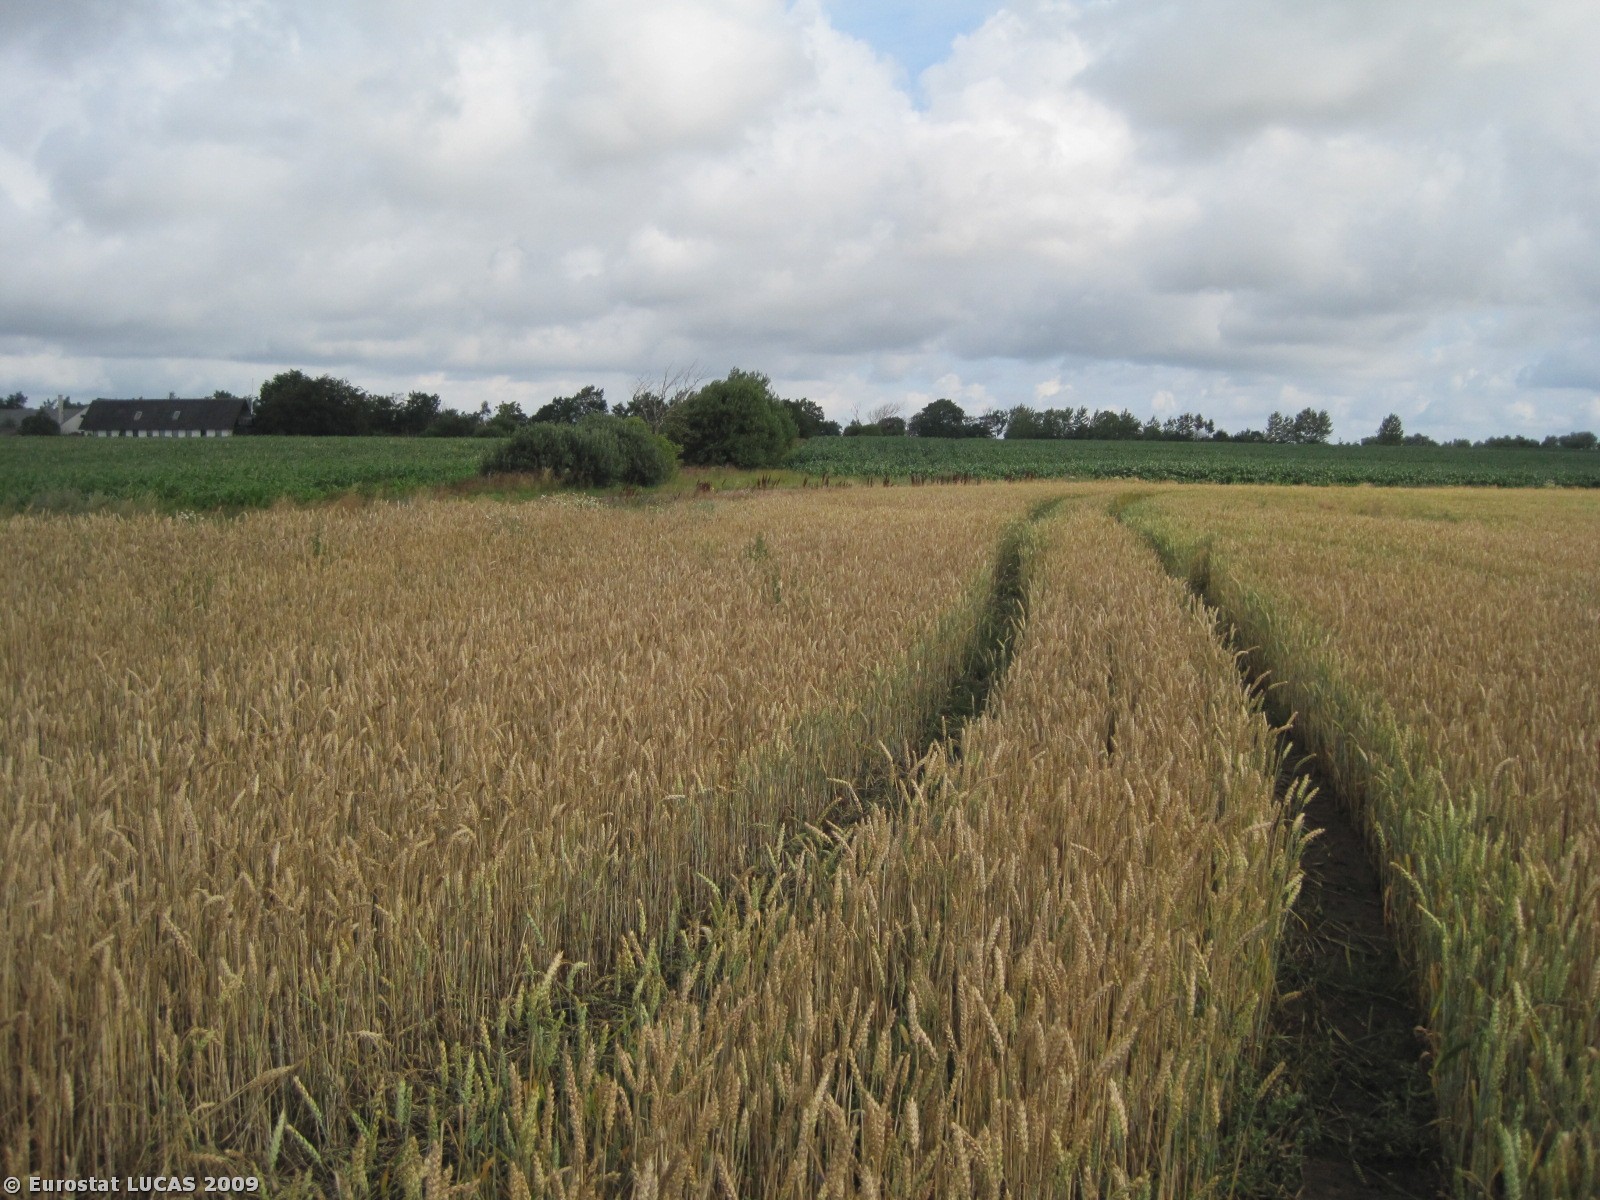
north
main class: Cropland
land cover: Common wheat
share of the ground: > 75 %
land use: Agriculture (excluding fallow land and kitchen gardens)
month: July
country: DK
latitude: 57.0483
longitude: 9.2264
